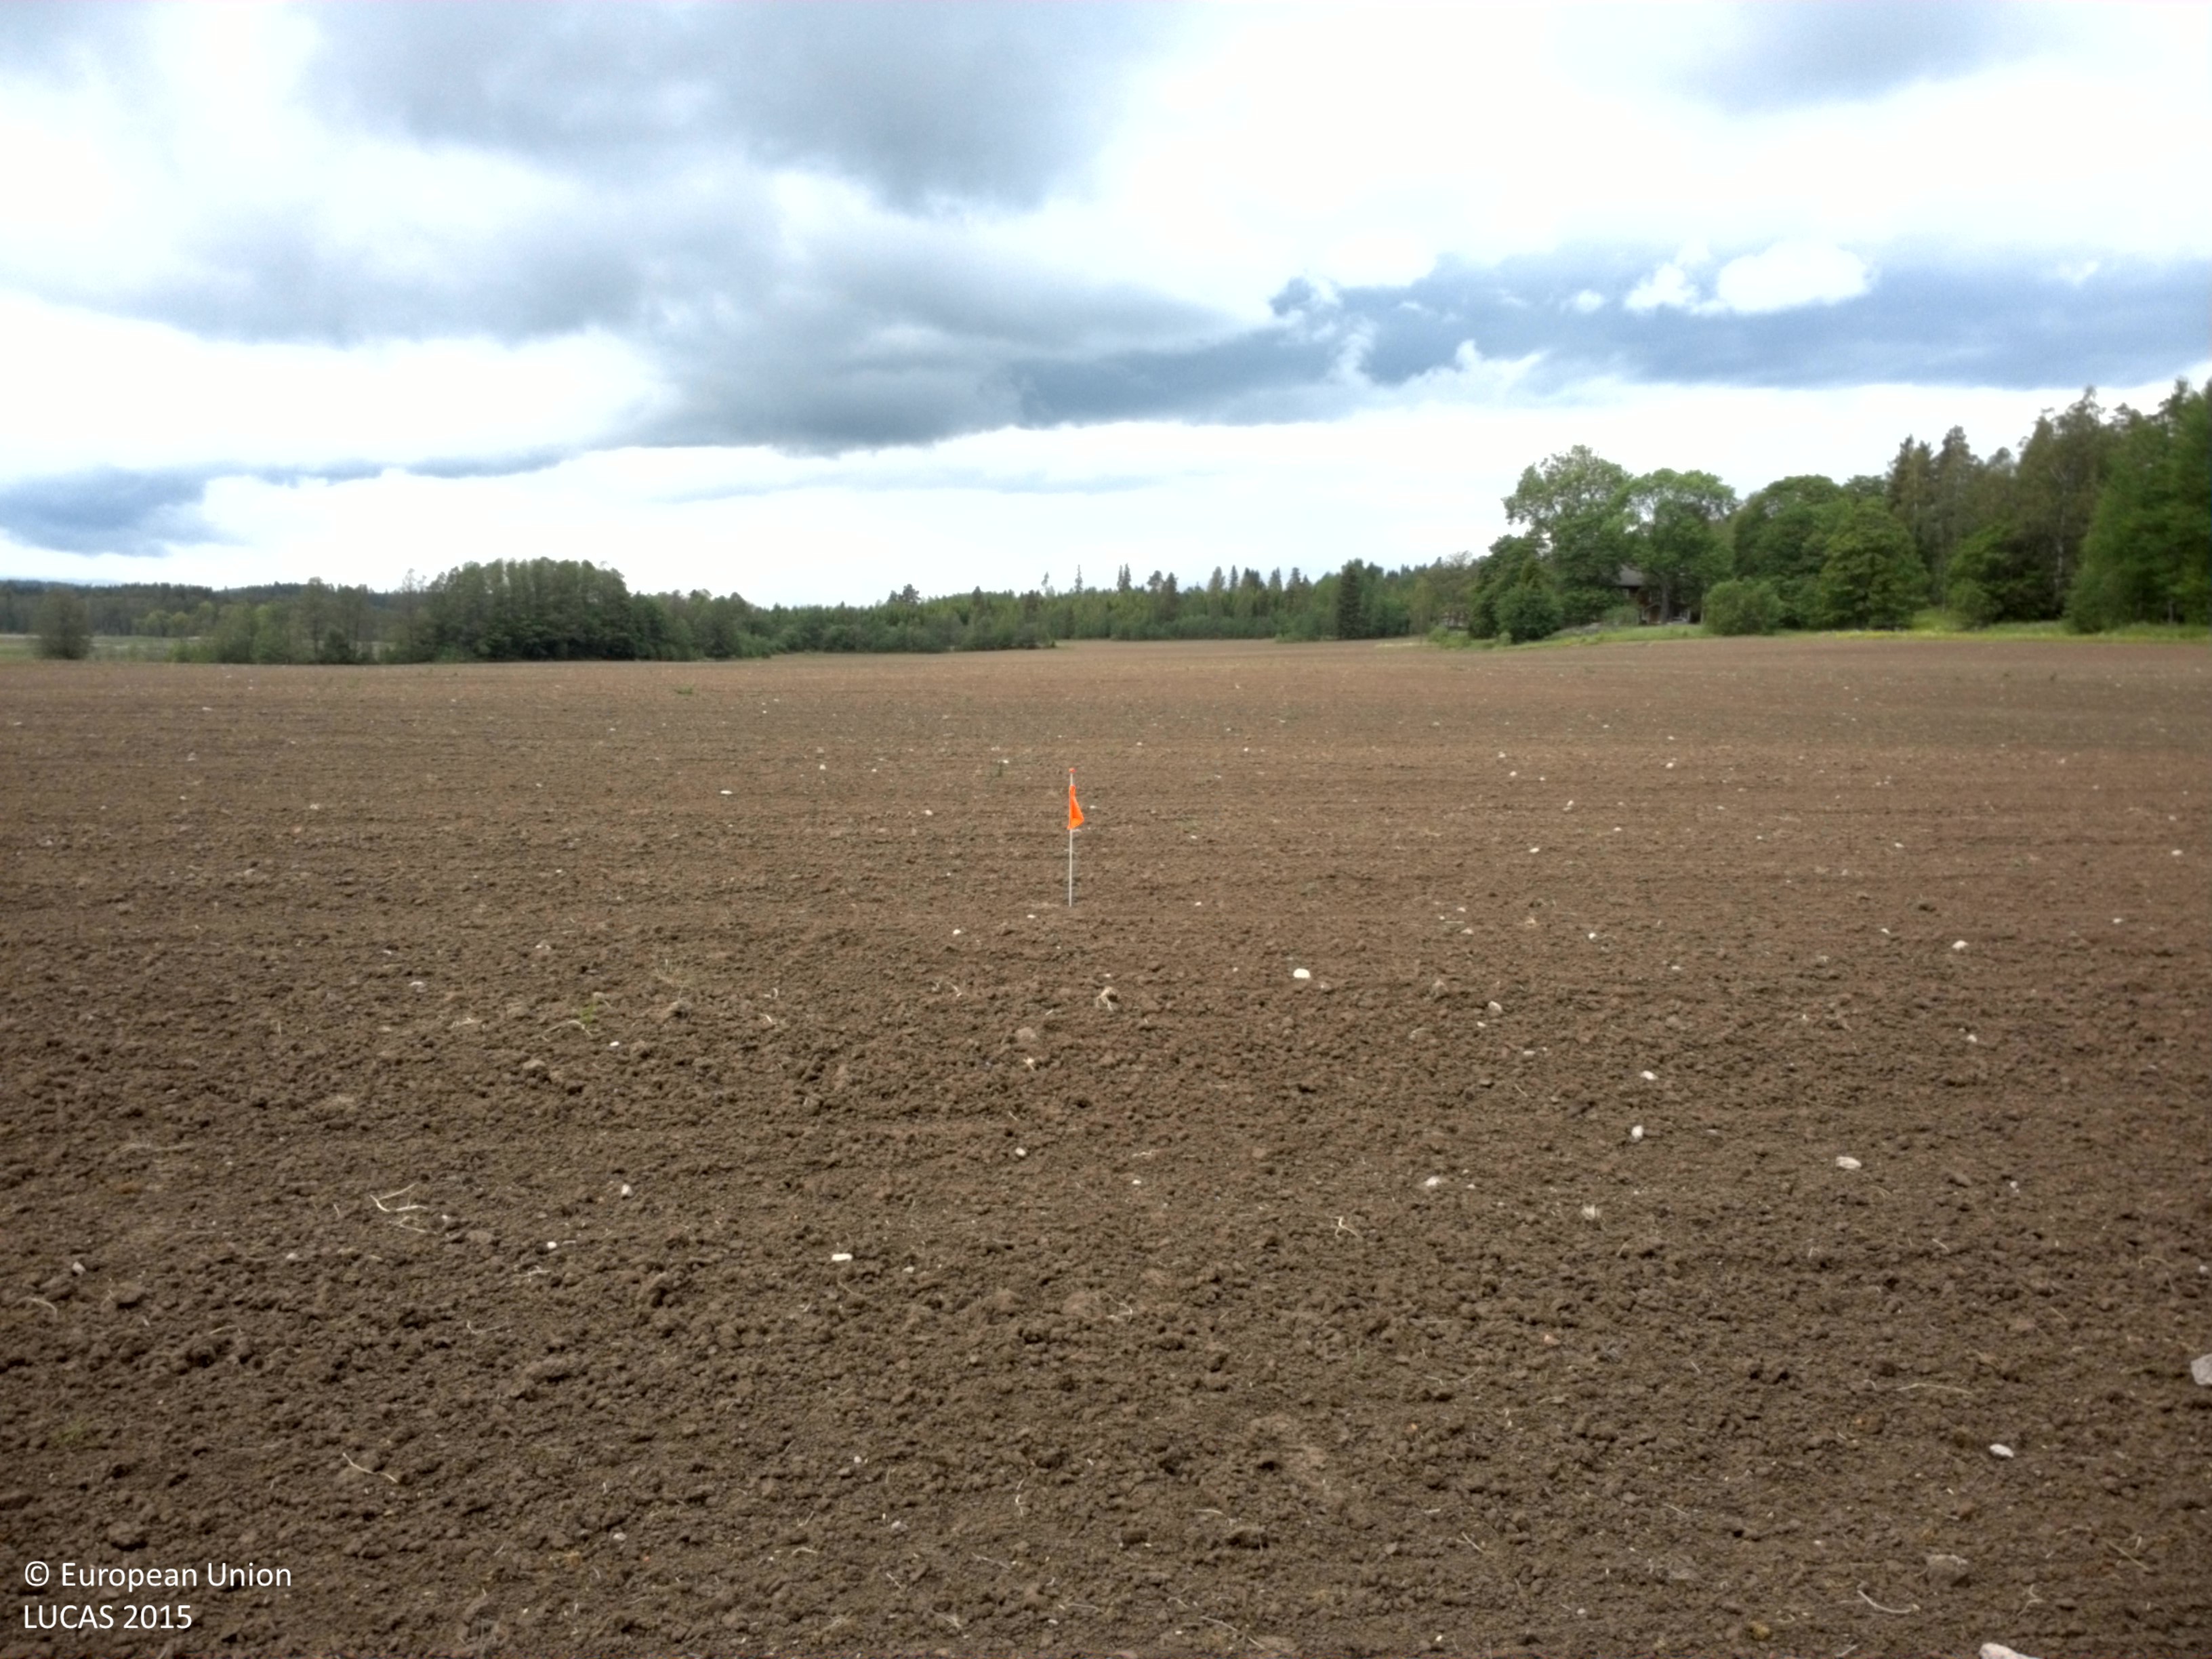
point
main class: Cropland
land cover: Oats
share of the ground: < 10 %
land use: Agriculture (excluding fallow land and kitchen gardens)
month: June
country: SE
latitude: 59.2638
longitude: 14.4297
